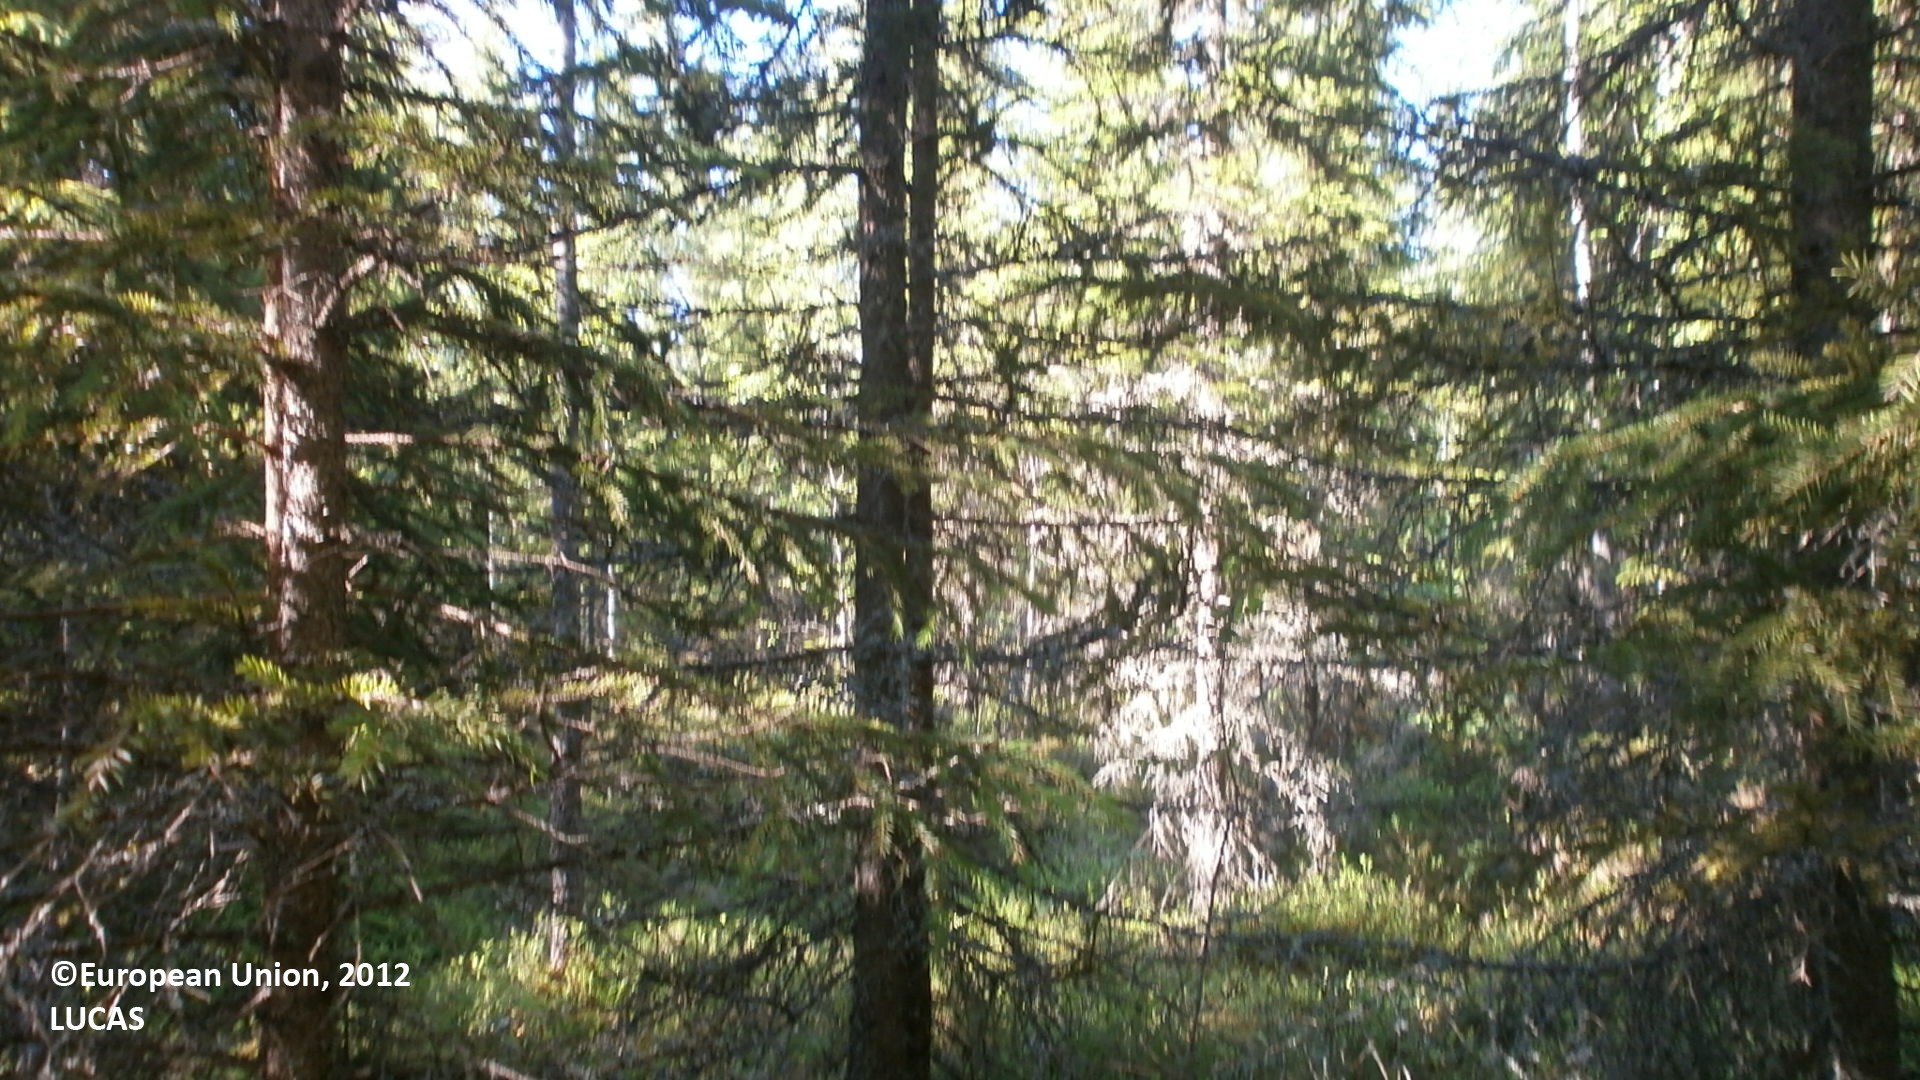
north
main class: Woodland
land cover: Spruce dominated coniferous woodland
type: boreal forest
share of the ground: > 75 %
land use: Forestry
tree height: > 5 m
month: July
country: FI
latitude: 64.0723
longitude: 24.9444
